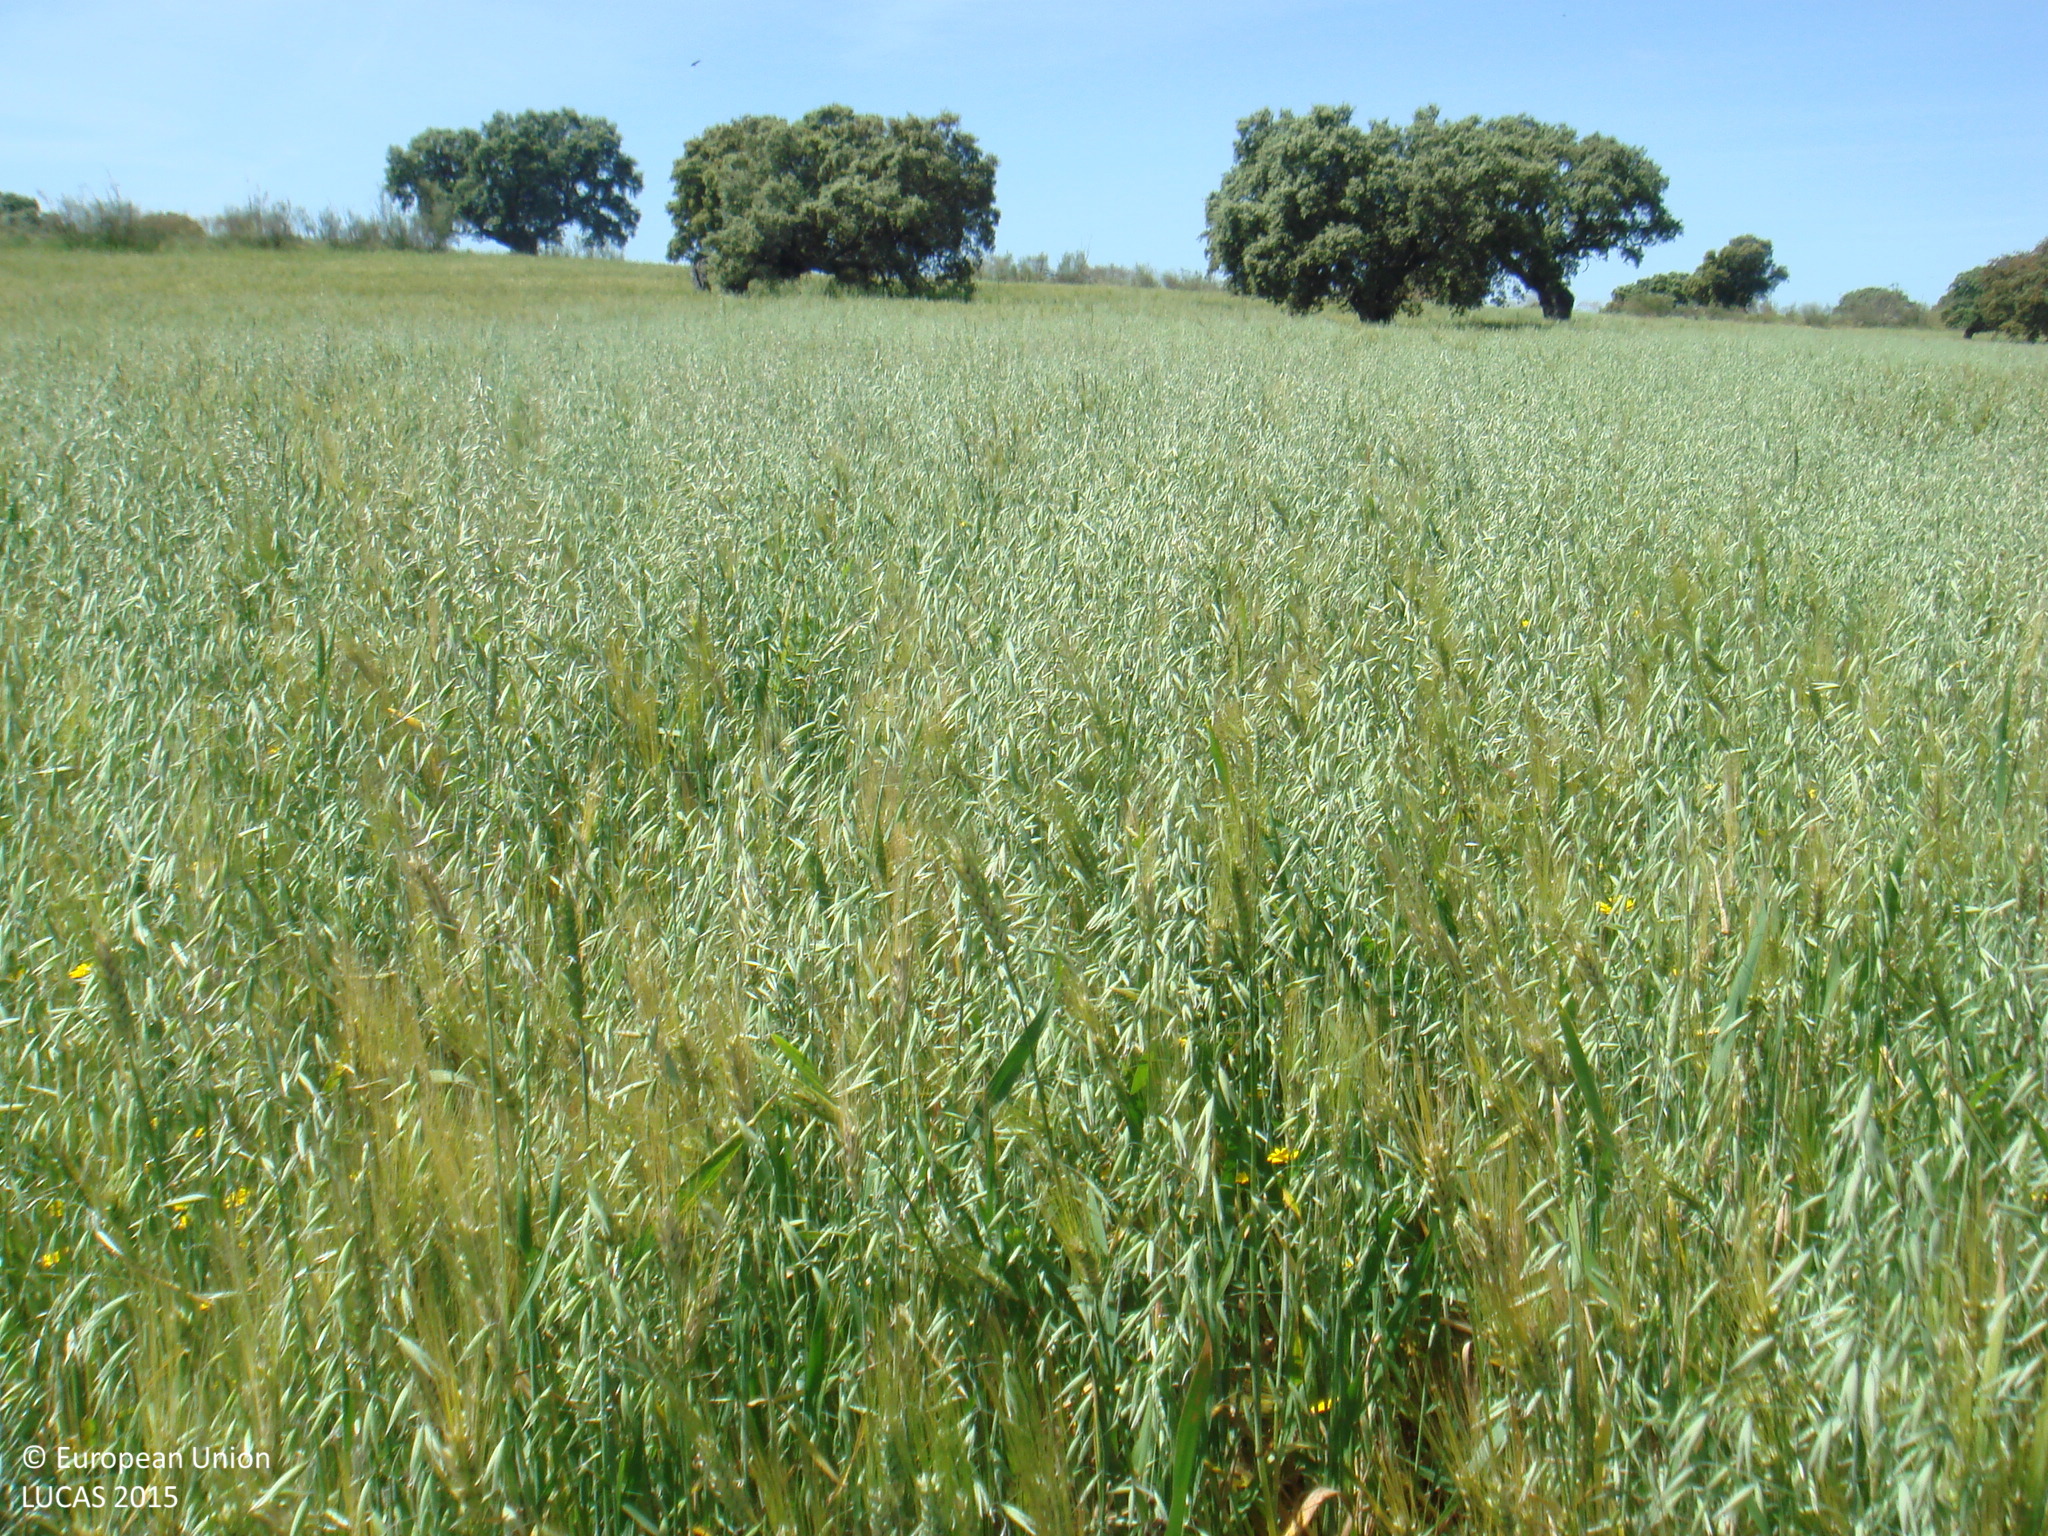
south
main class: Cropland
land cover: Mixed cereals for fodder
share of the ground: > 75 %
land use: Agriculture (excluding fallow land and kitchen gardens)
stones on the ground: 10 - 25 %
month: April
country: ES
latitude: 38.5088
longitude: -5.0630
